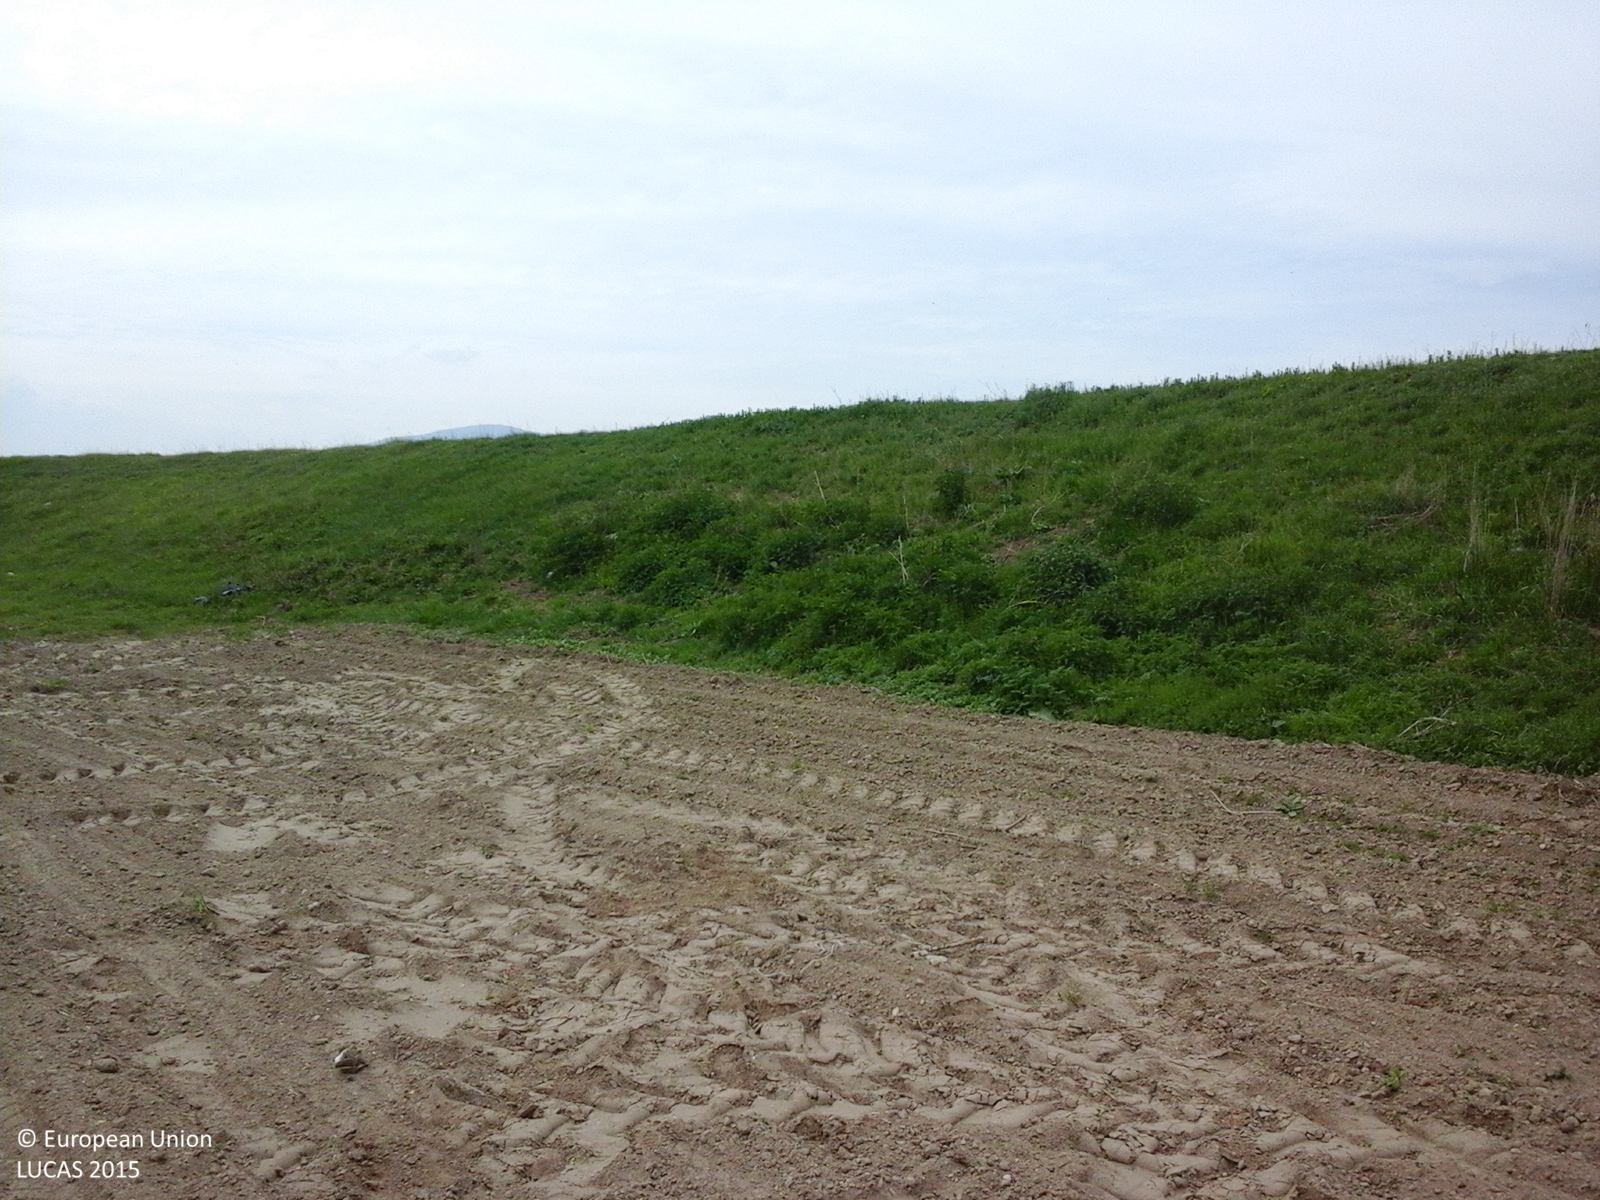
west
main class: Cropland
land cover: Maize
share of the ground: < 10 %
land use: Agriculture (excluding fallow land and kitchen gardens)
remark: Tilled/Sowed
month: May
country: RO
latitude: 45.7347
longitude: 25.5643
